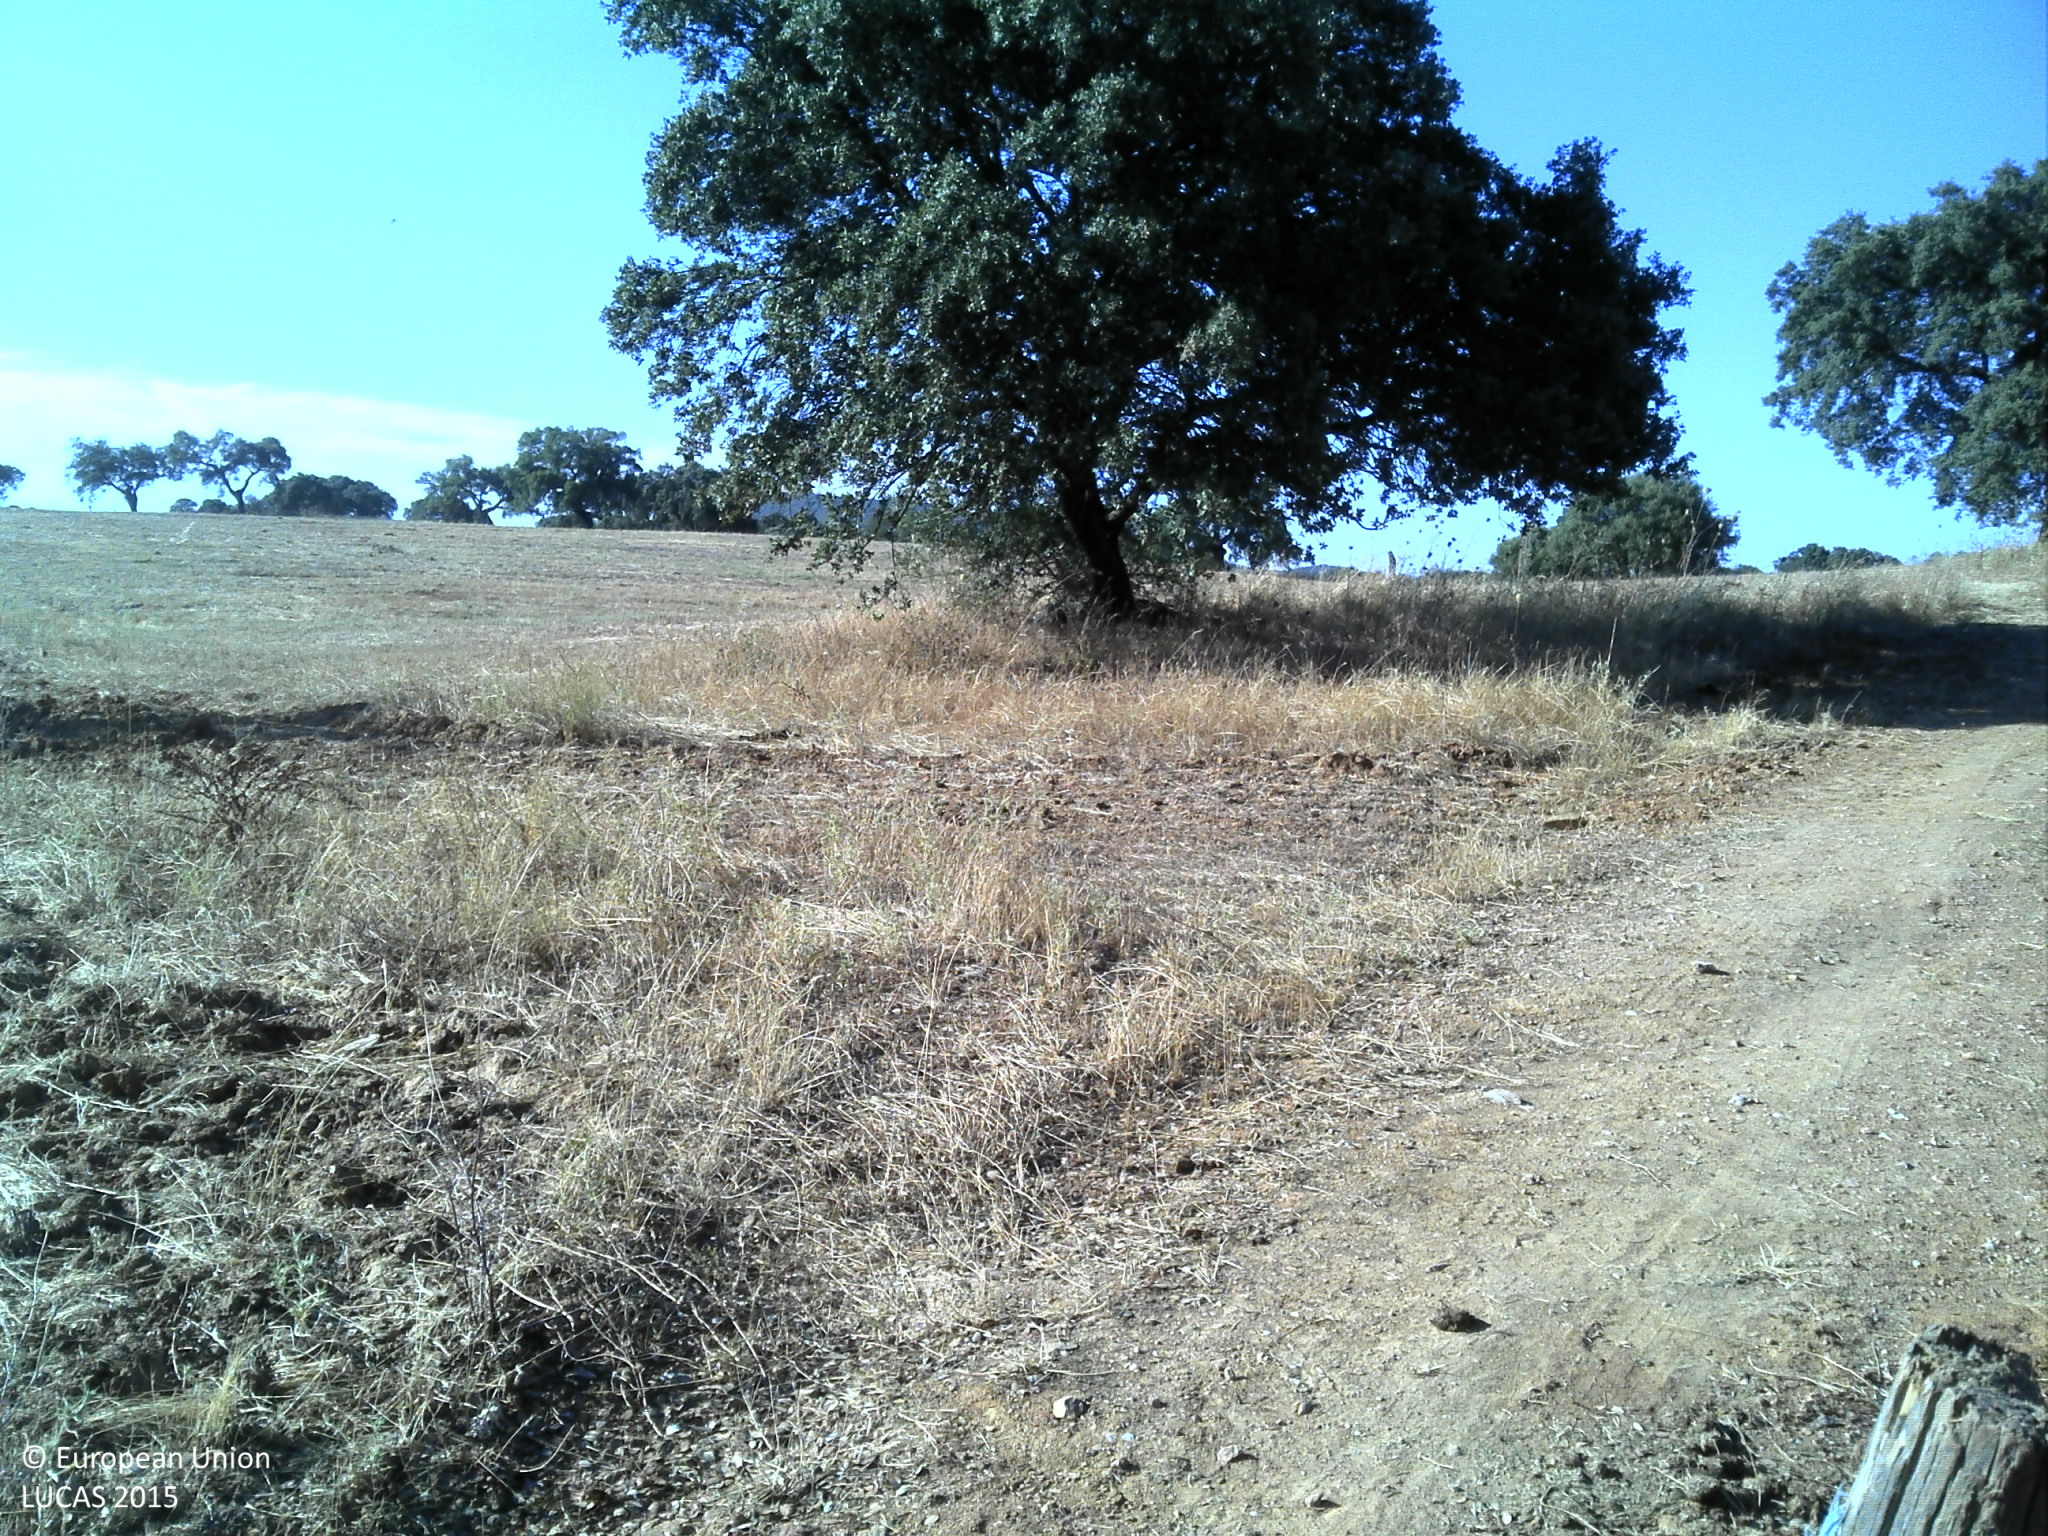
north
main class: Grassland
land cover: Grassland without tree/shrub cover
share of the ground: > 75 %
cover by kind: herbaceous plants 100 %
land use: Agriculture (excluding fallow land and kitchen gardens)
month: June
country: PT
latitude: 37.9773
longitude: -7.3075
